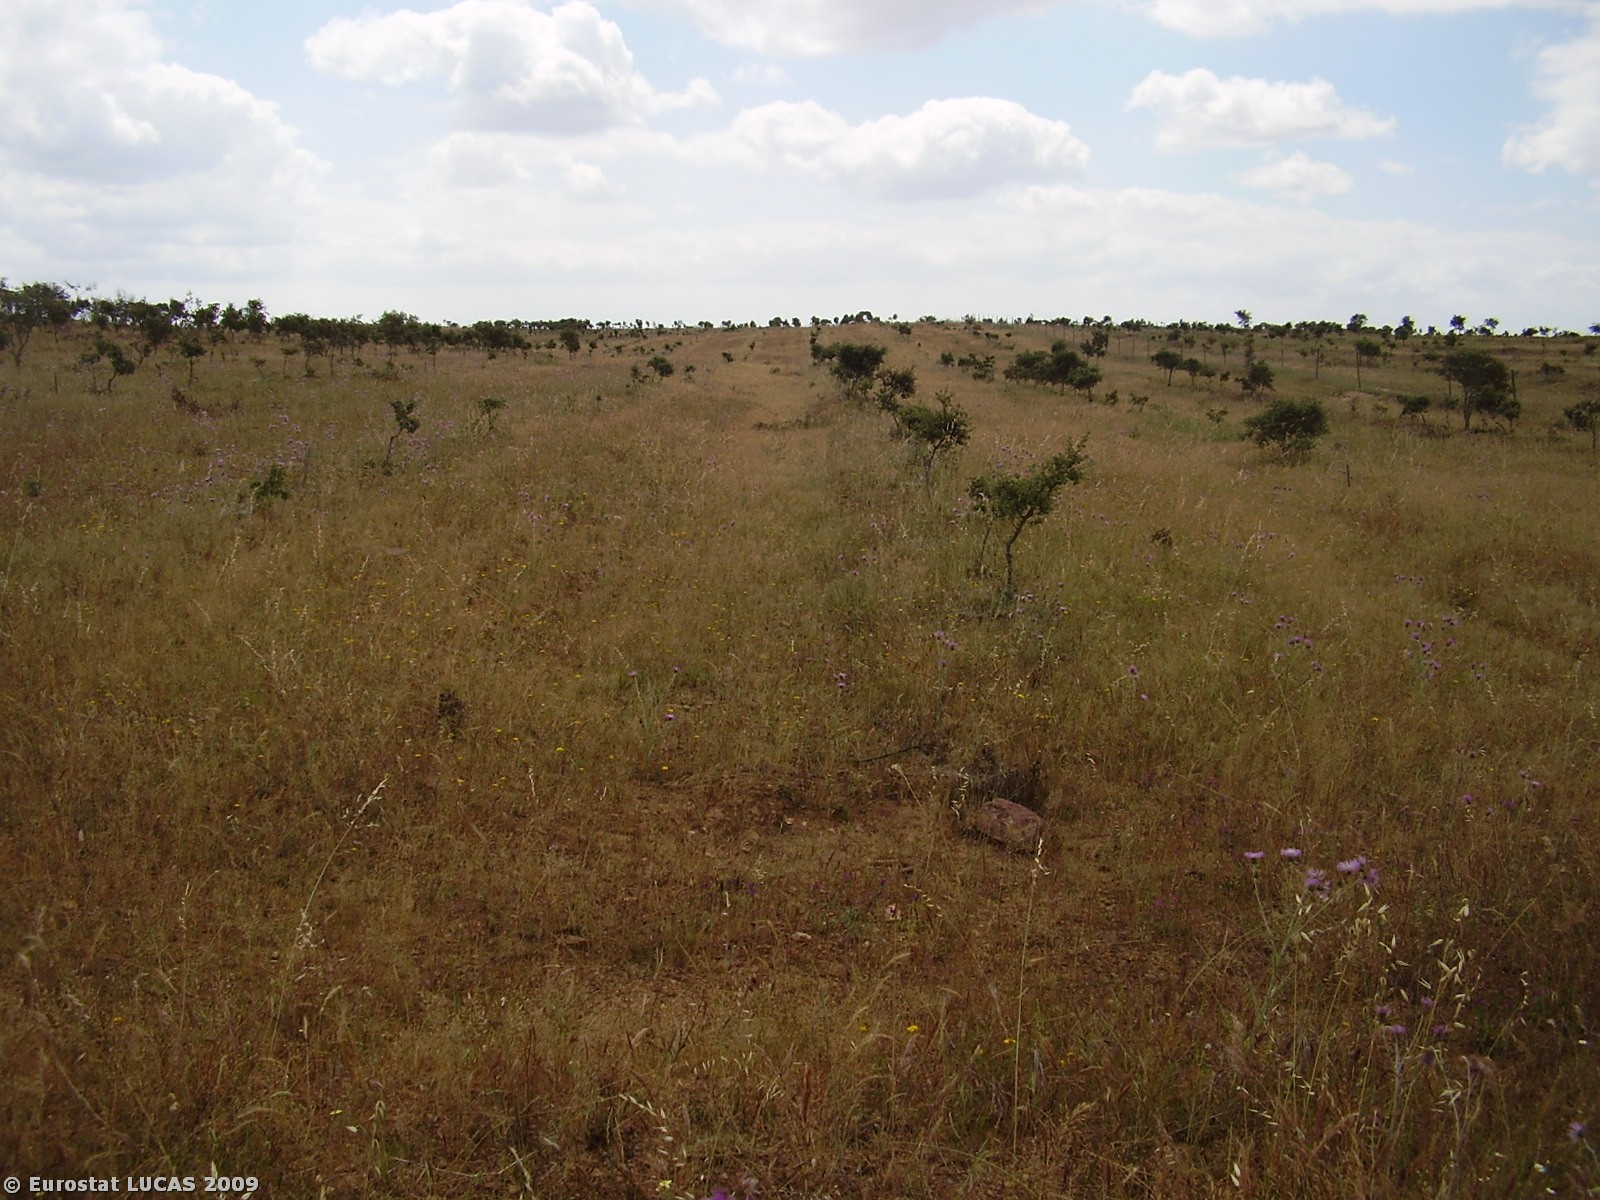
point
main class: Woodland
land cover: Broadleaved woodland
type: broadleaved evergreen forest
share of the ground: 25 - 50 %
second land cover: Spontaneously vegetated surfaces
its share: > 75 %
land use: Forestry
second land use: Fallow land
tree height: > 5 m
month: May
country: PT
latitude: 37.7948
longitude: -7.8874
